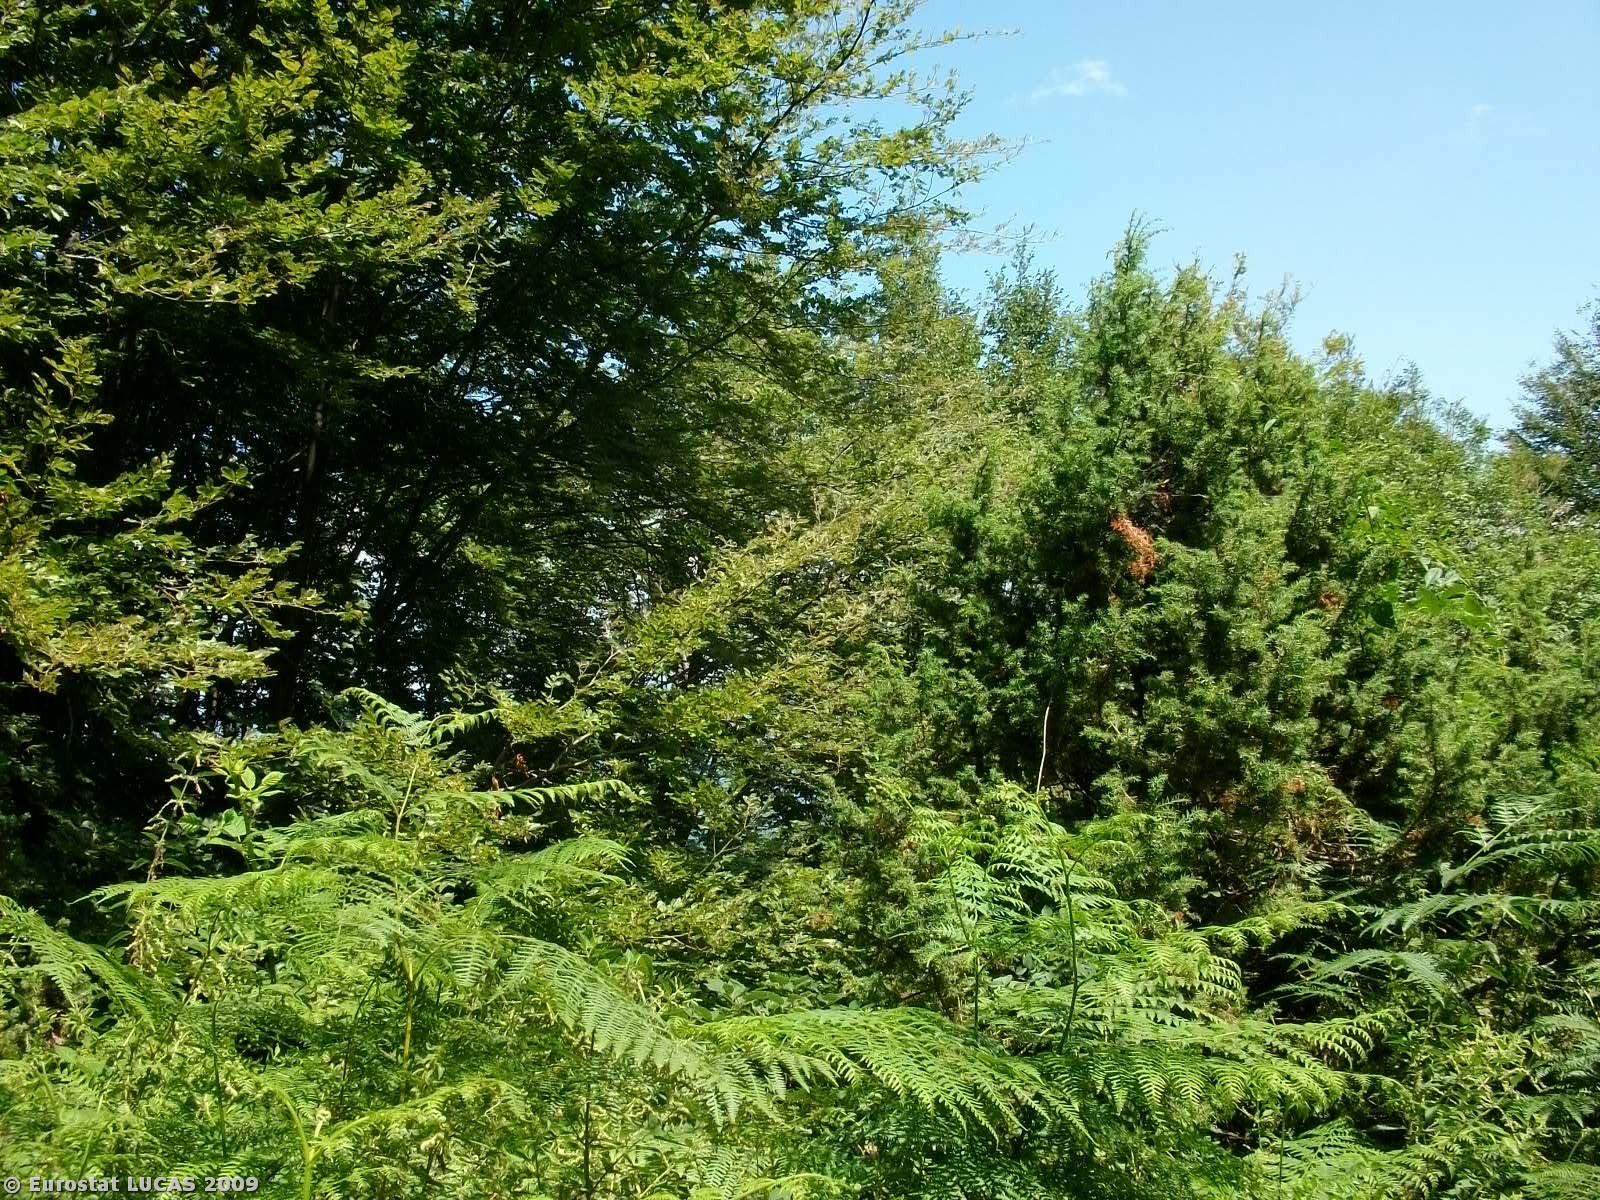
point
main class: Woodland
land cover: Broadleaved woodland
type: beech forest
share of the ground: > 75 %
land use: Forestry
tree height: > 5 m
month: August
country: GR
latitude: 41.2987
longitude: 24.2080
